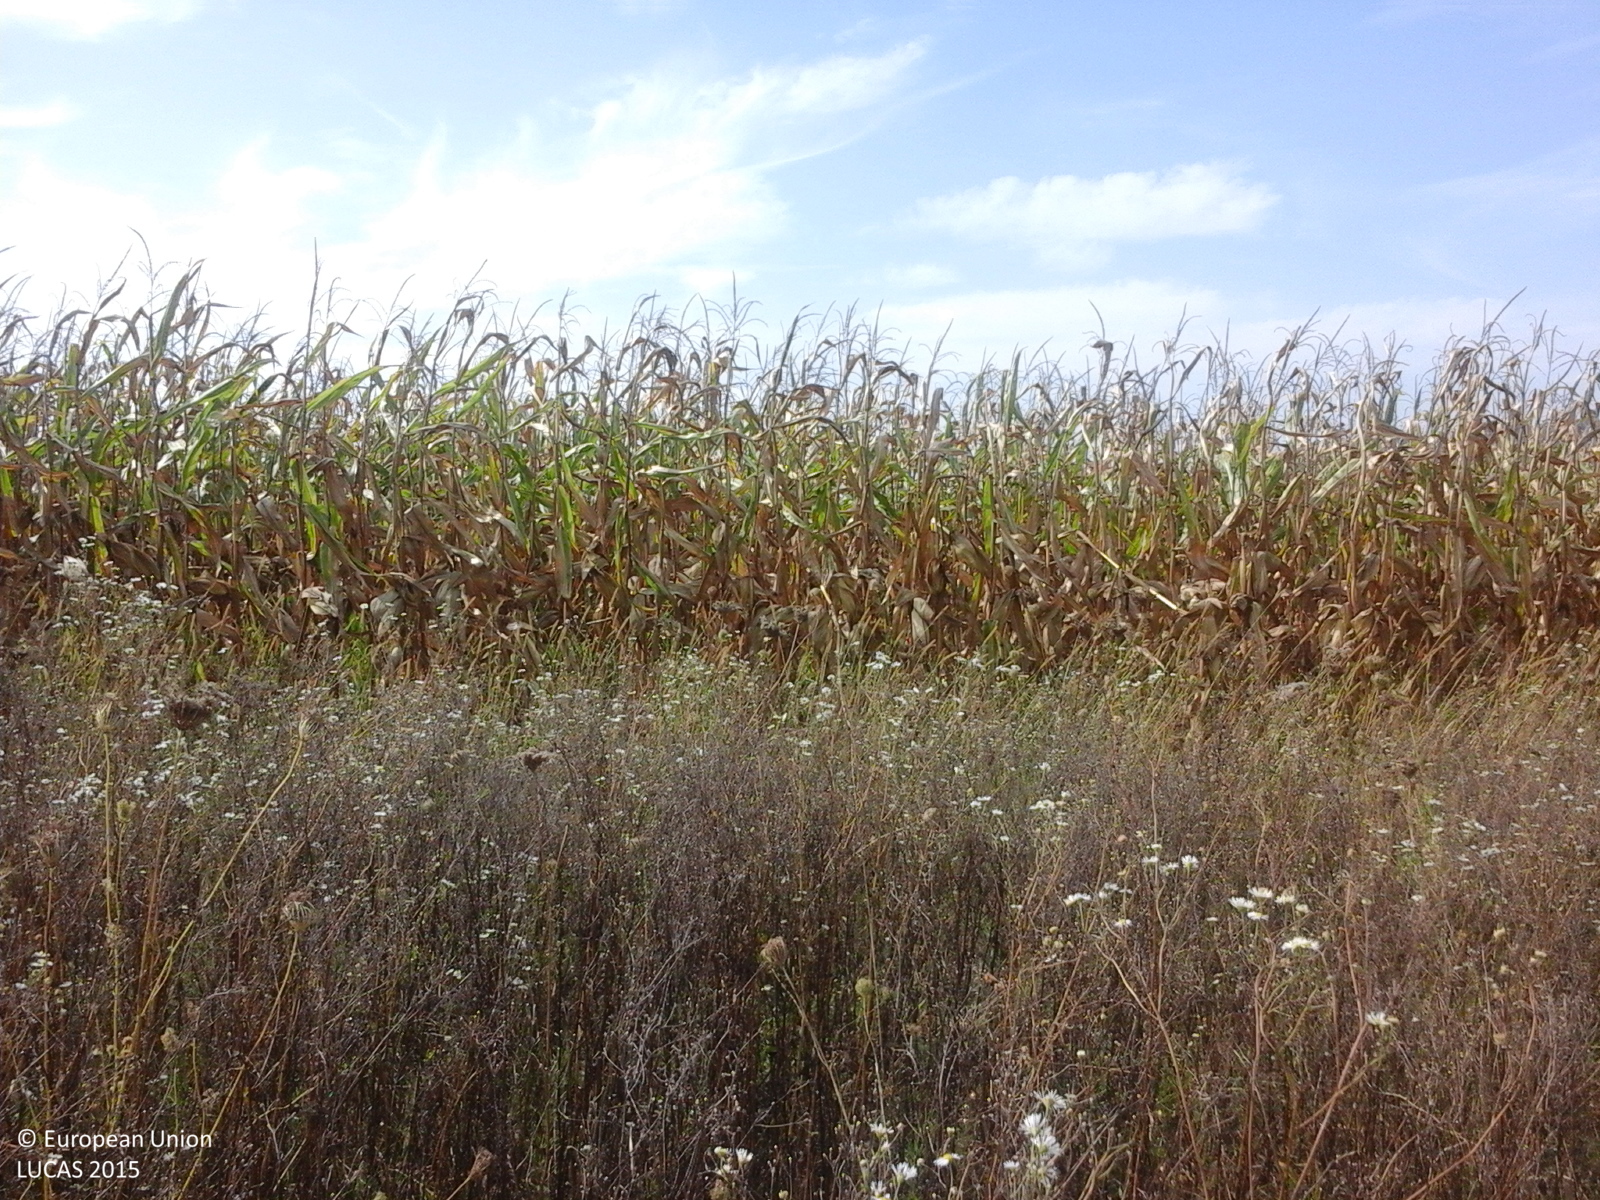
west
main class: Grassland
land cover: Spontaneously vegetated surfaces
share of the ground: > 75 %
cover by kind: herbaceous plants 100 %
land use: Fallow land
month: September
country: RO
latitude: 47.2714
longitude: 23.7040
